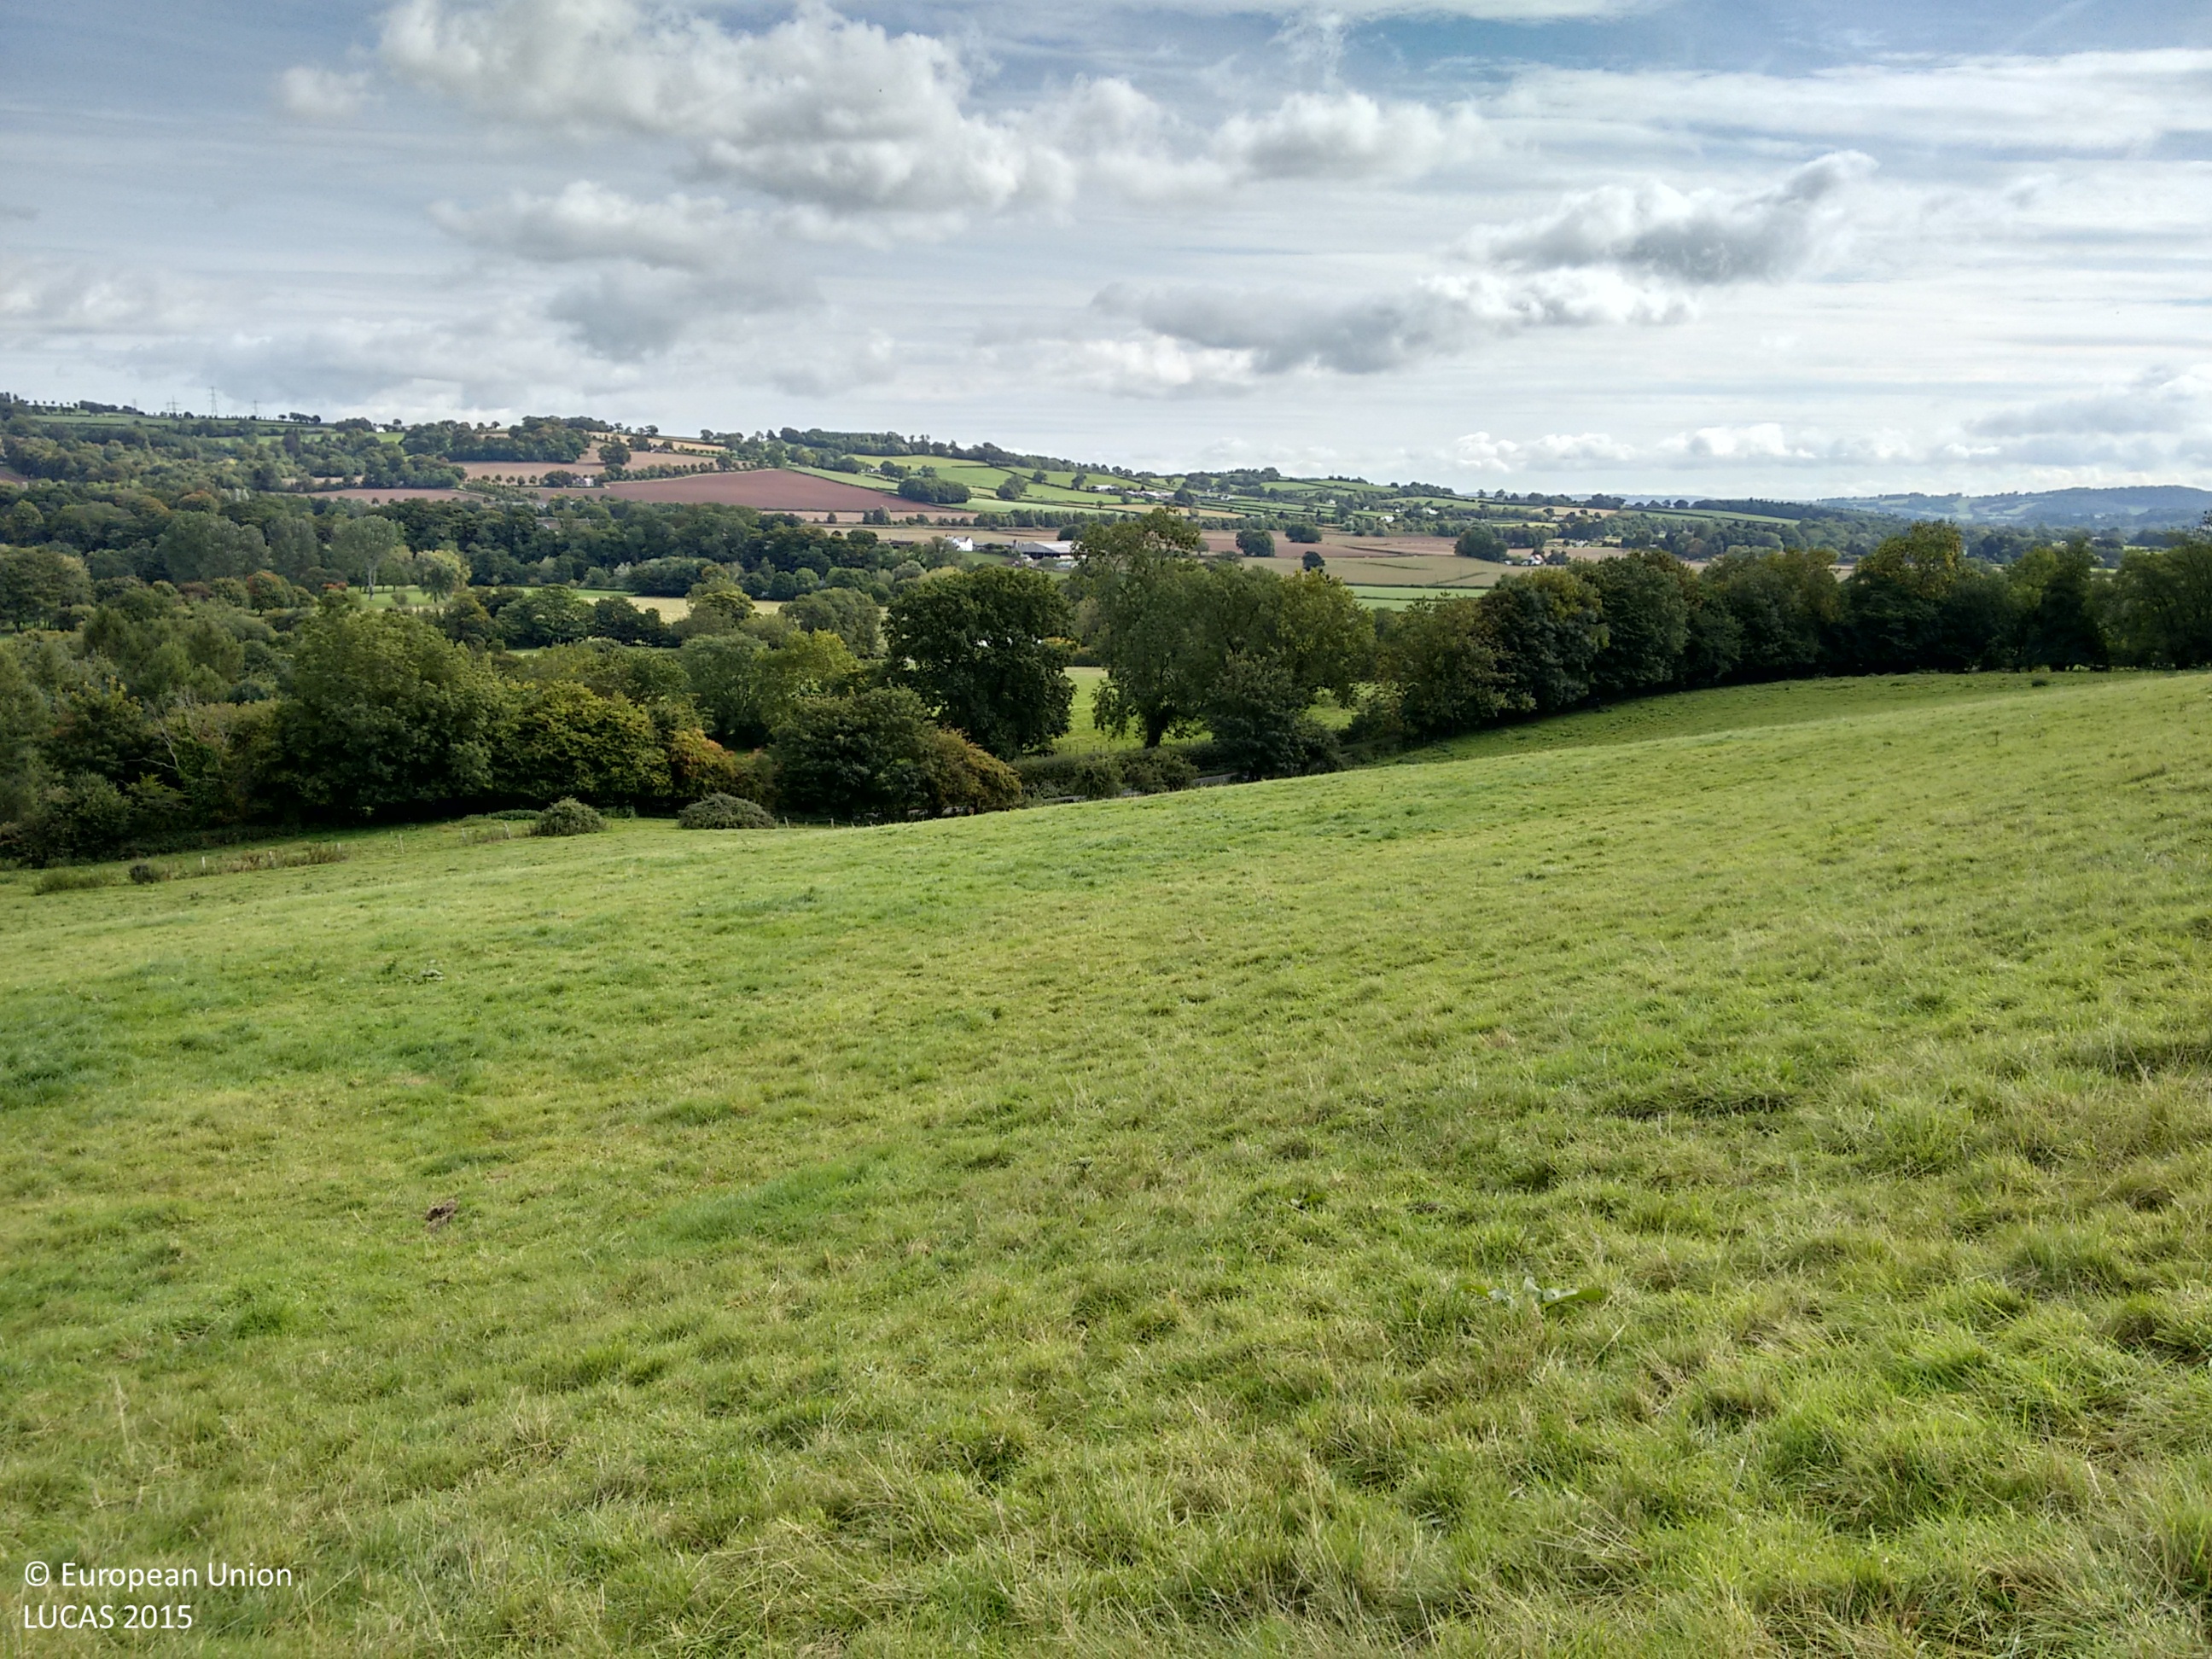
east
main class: Grassland
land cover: Grassland without tree/shrub cover
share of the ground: > 75 %
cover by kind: herbaceous plants 100 %
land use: Agriculture (excluding fallow land and kitchen gardens)
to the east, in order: Grassland without tree/shrub cover; Managed hedges; Dry stone walls; Grass margins; Paved roads, cycling and walking lanes; Grass margins; Managed hedges; Fences; Grassland with sparse tree/shrub cover; Fences; Grassland without tree/shrub cover
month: September
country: GB
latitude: 51.8016
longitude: -3.0256
